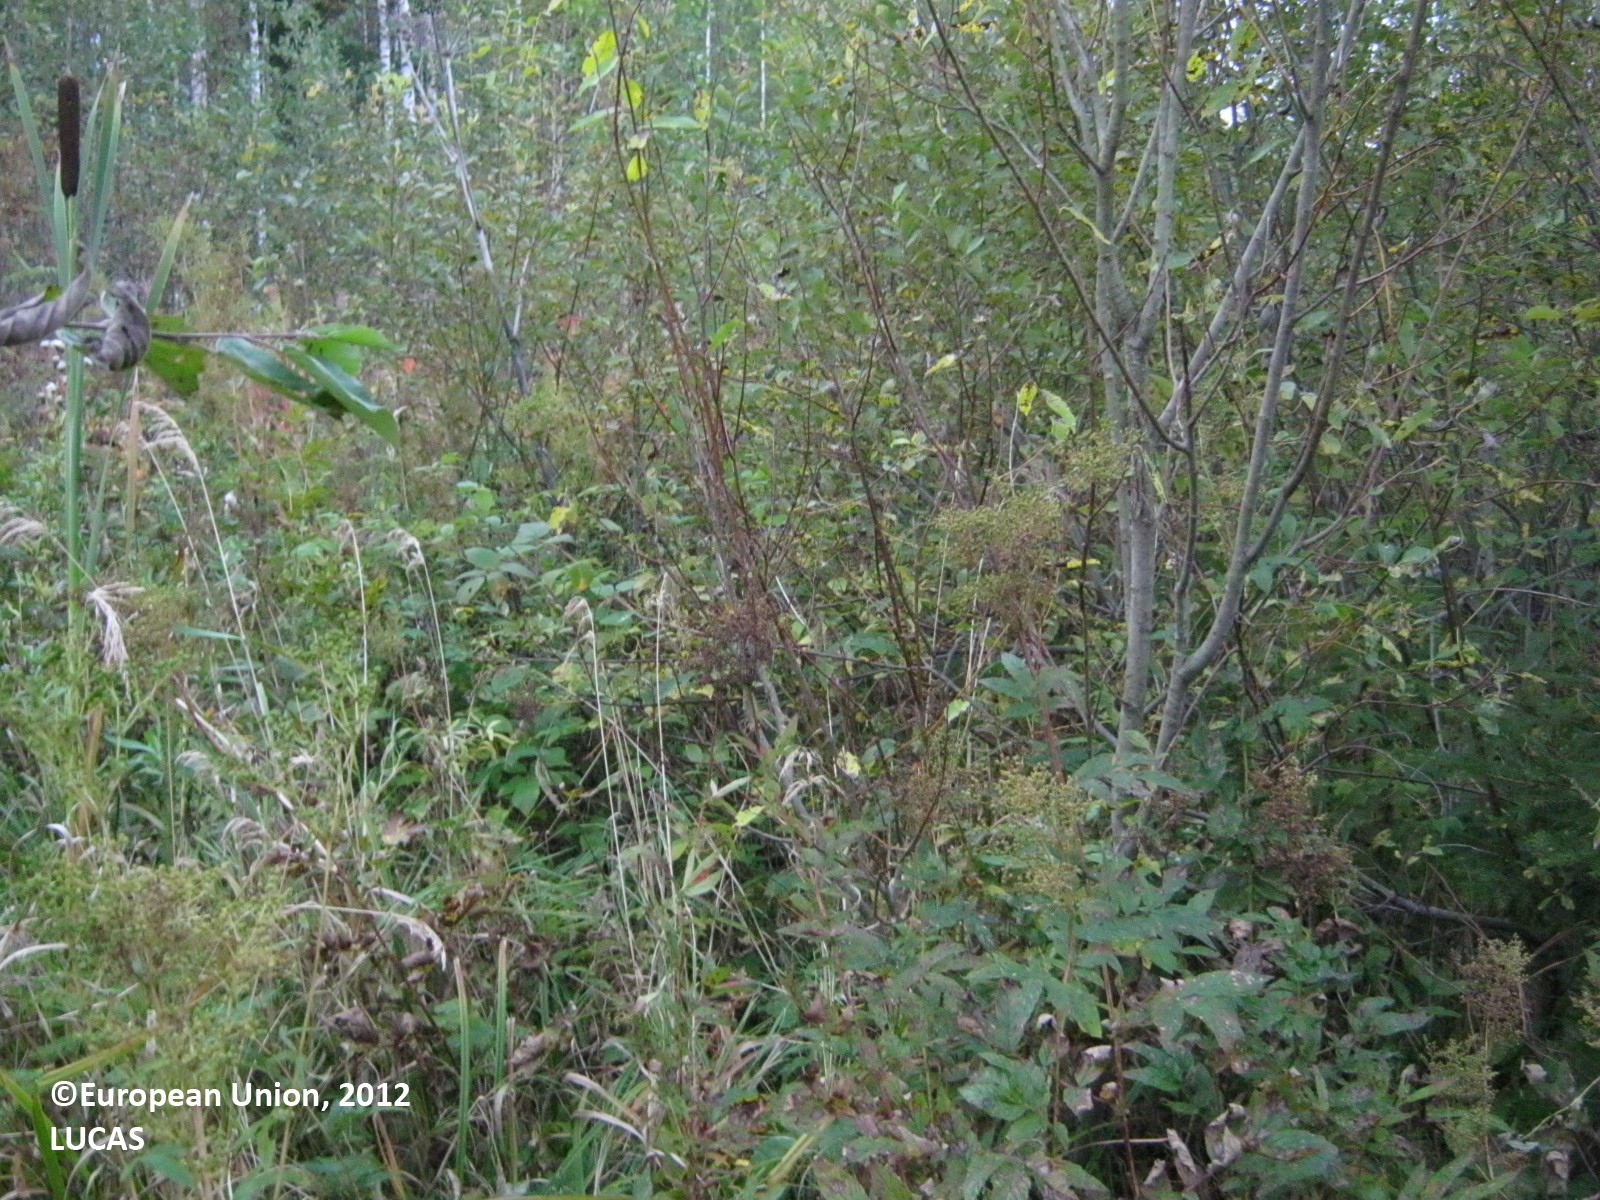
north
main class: Woodland
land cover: Broadleaved woodland
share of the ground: > 75 %
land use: Forestry
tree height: < 5 m
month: September
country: FI
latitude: 61.0083
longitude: 28.1639
